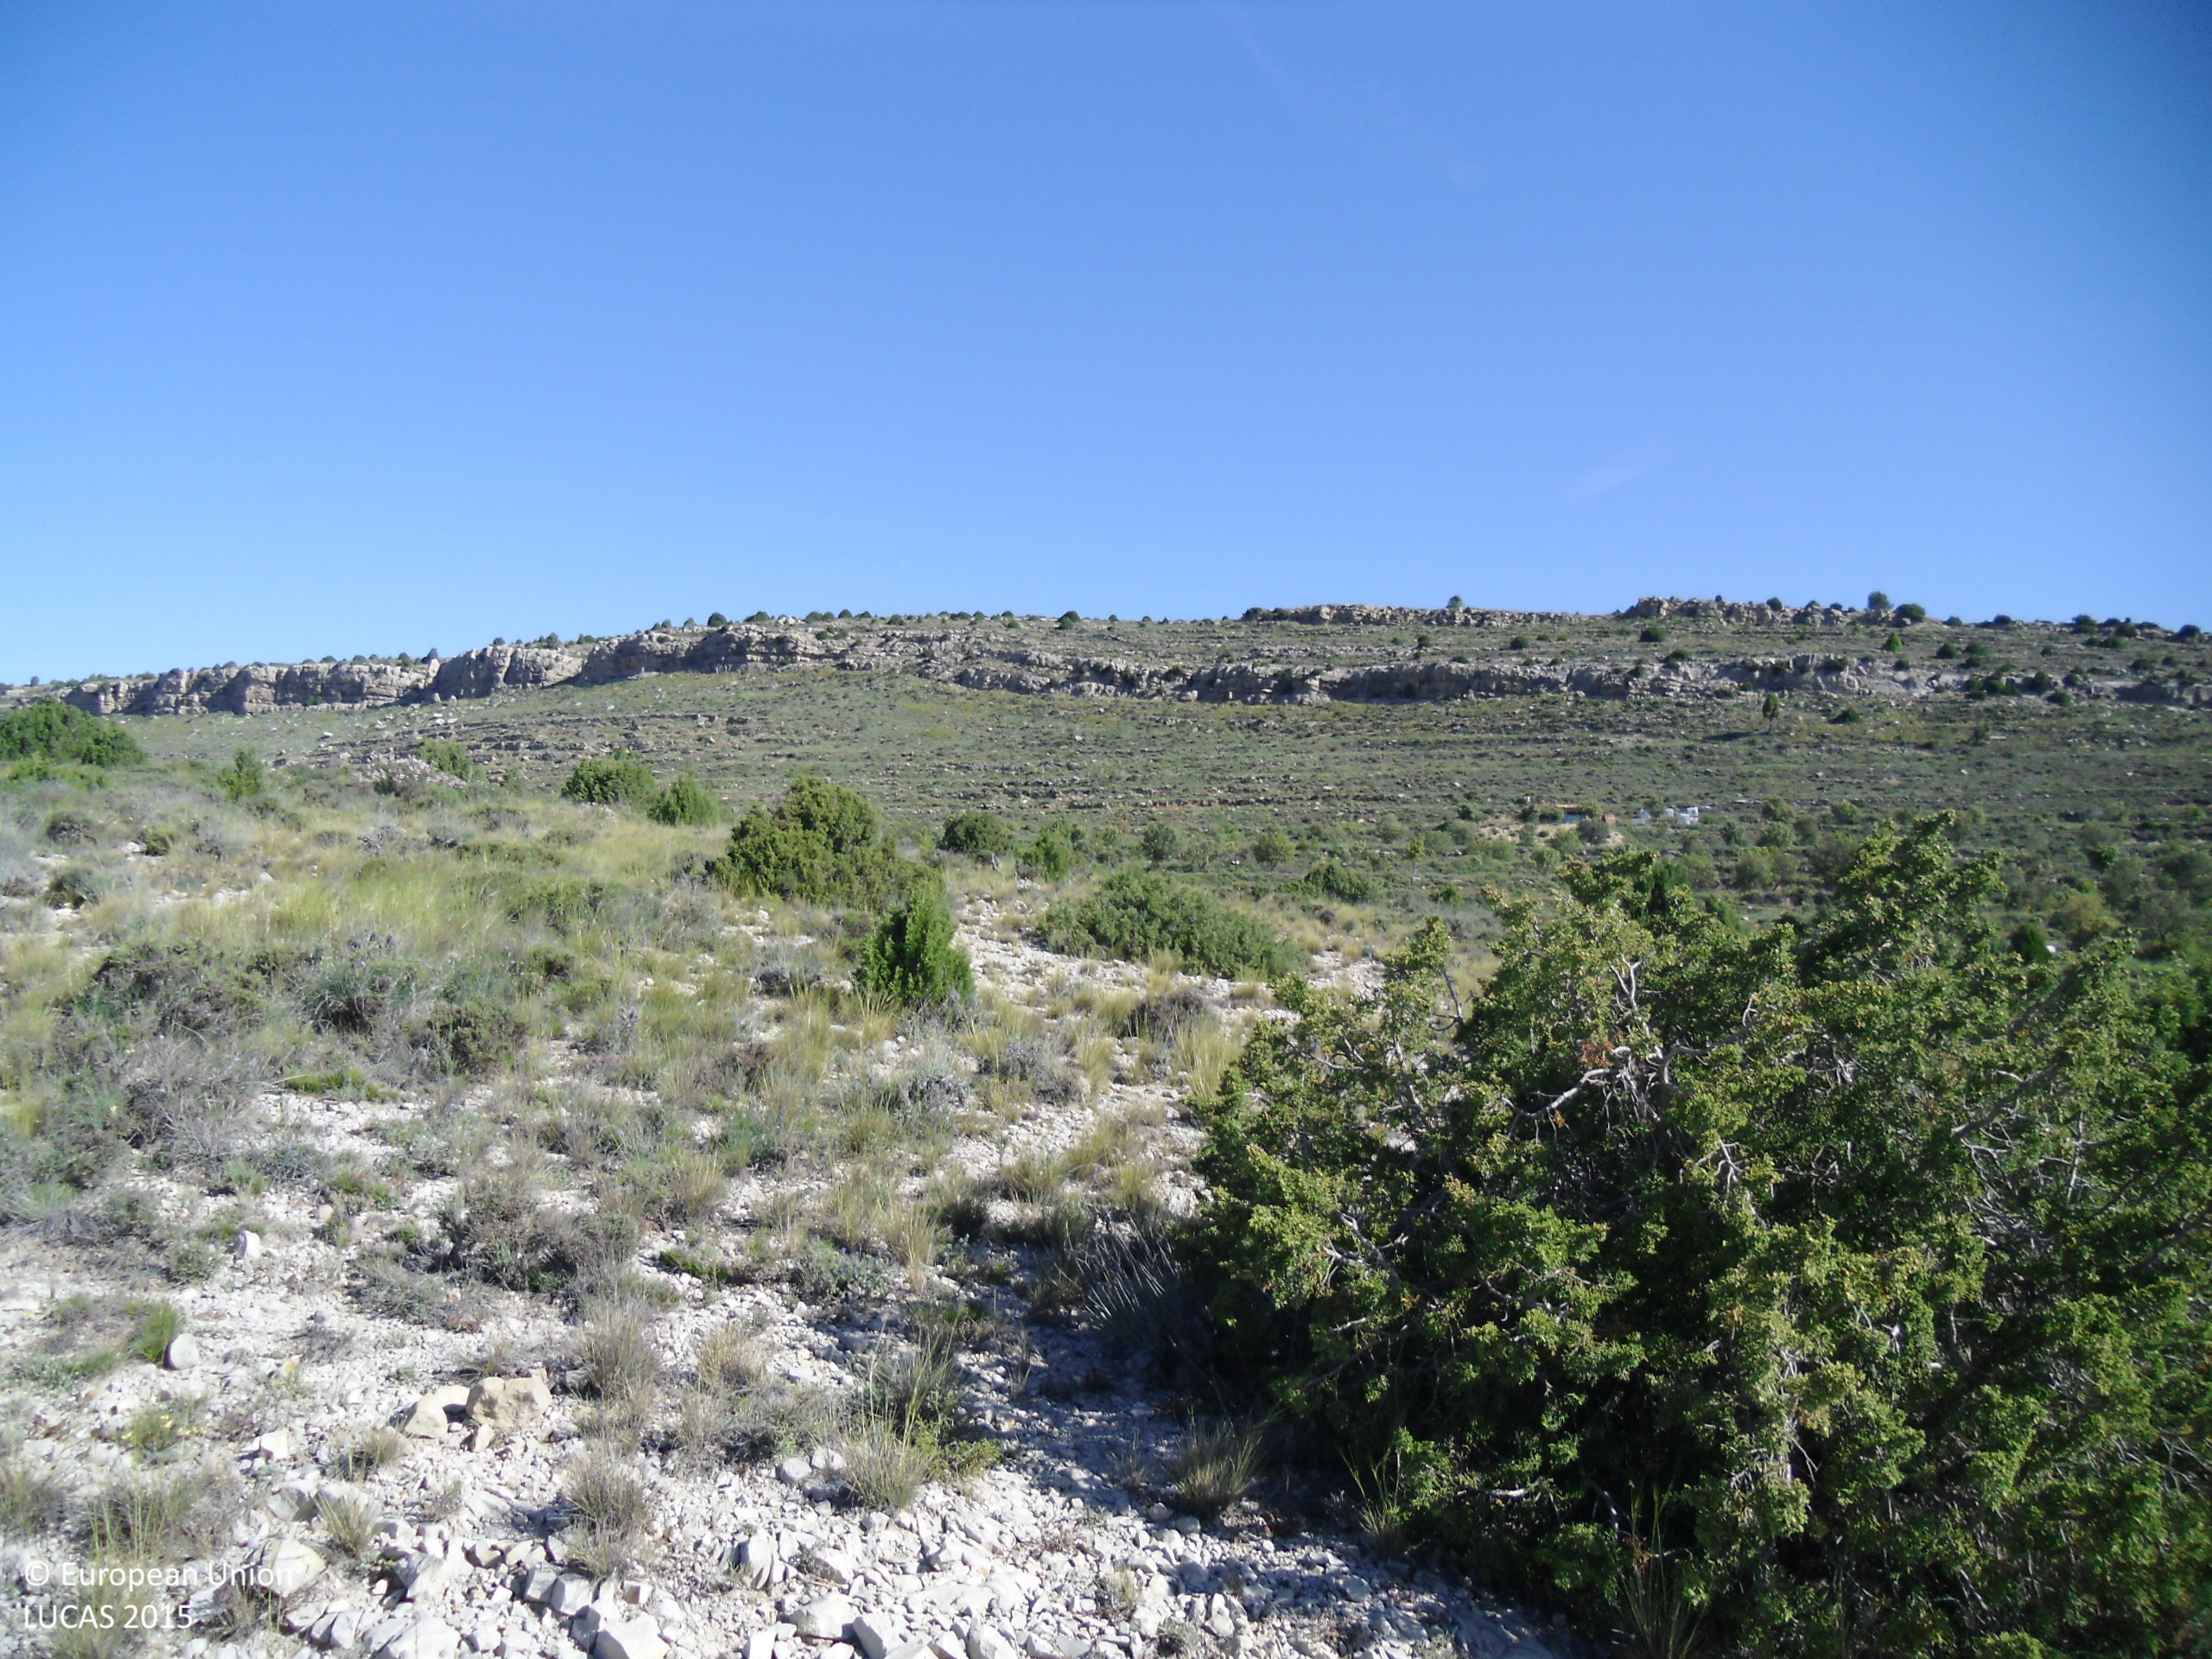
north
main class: Grassland
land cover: Grassland with sparse tree/shrub cover
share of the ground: > 75 %
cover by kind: herbaceous plants 95 %, coniferous forest trees 5 %
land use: Semi-natural and natural areas not in use
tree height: > 5 m
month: May
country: ES
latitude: 40.2440
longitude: -0.7160
